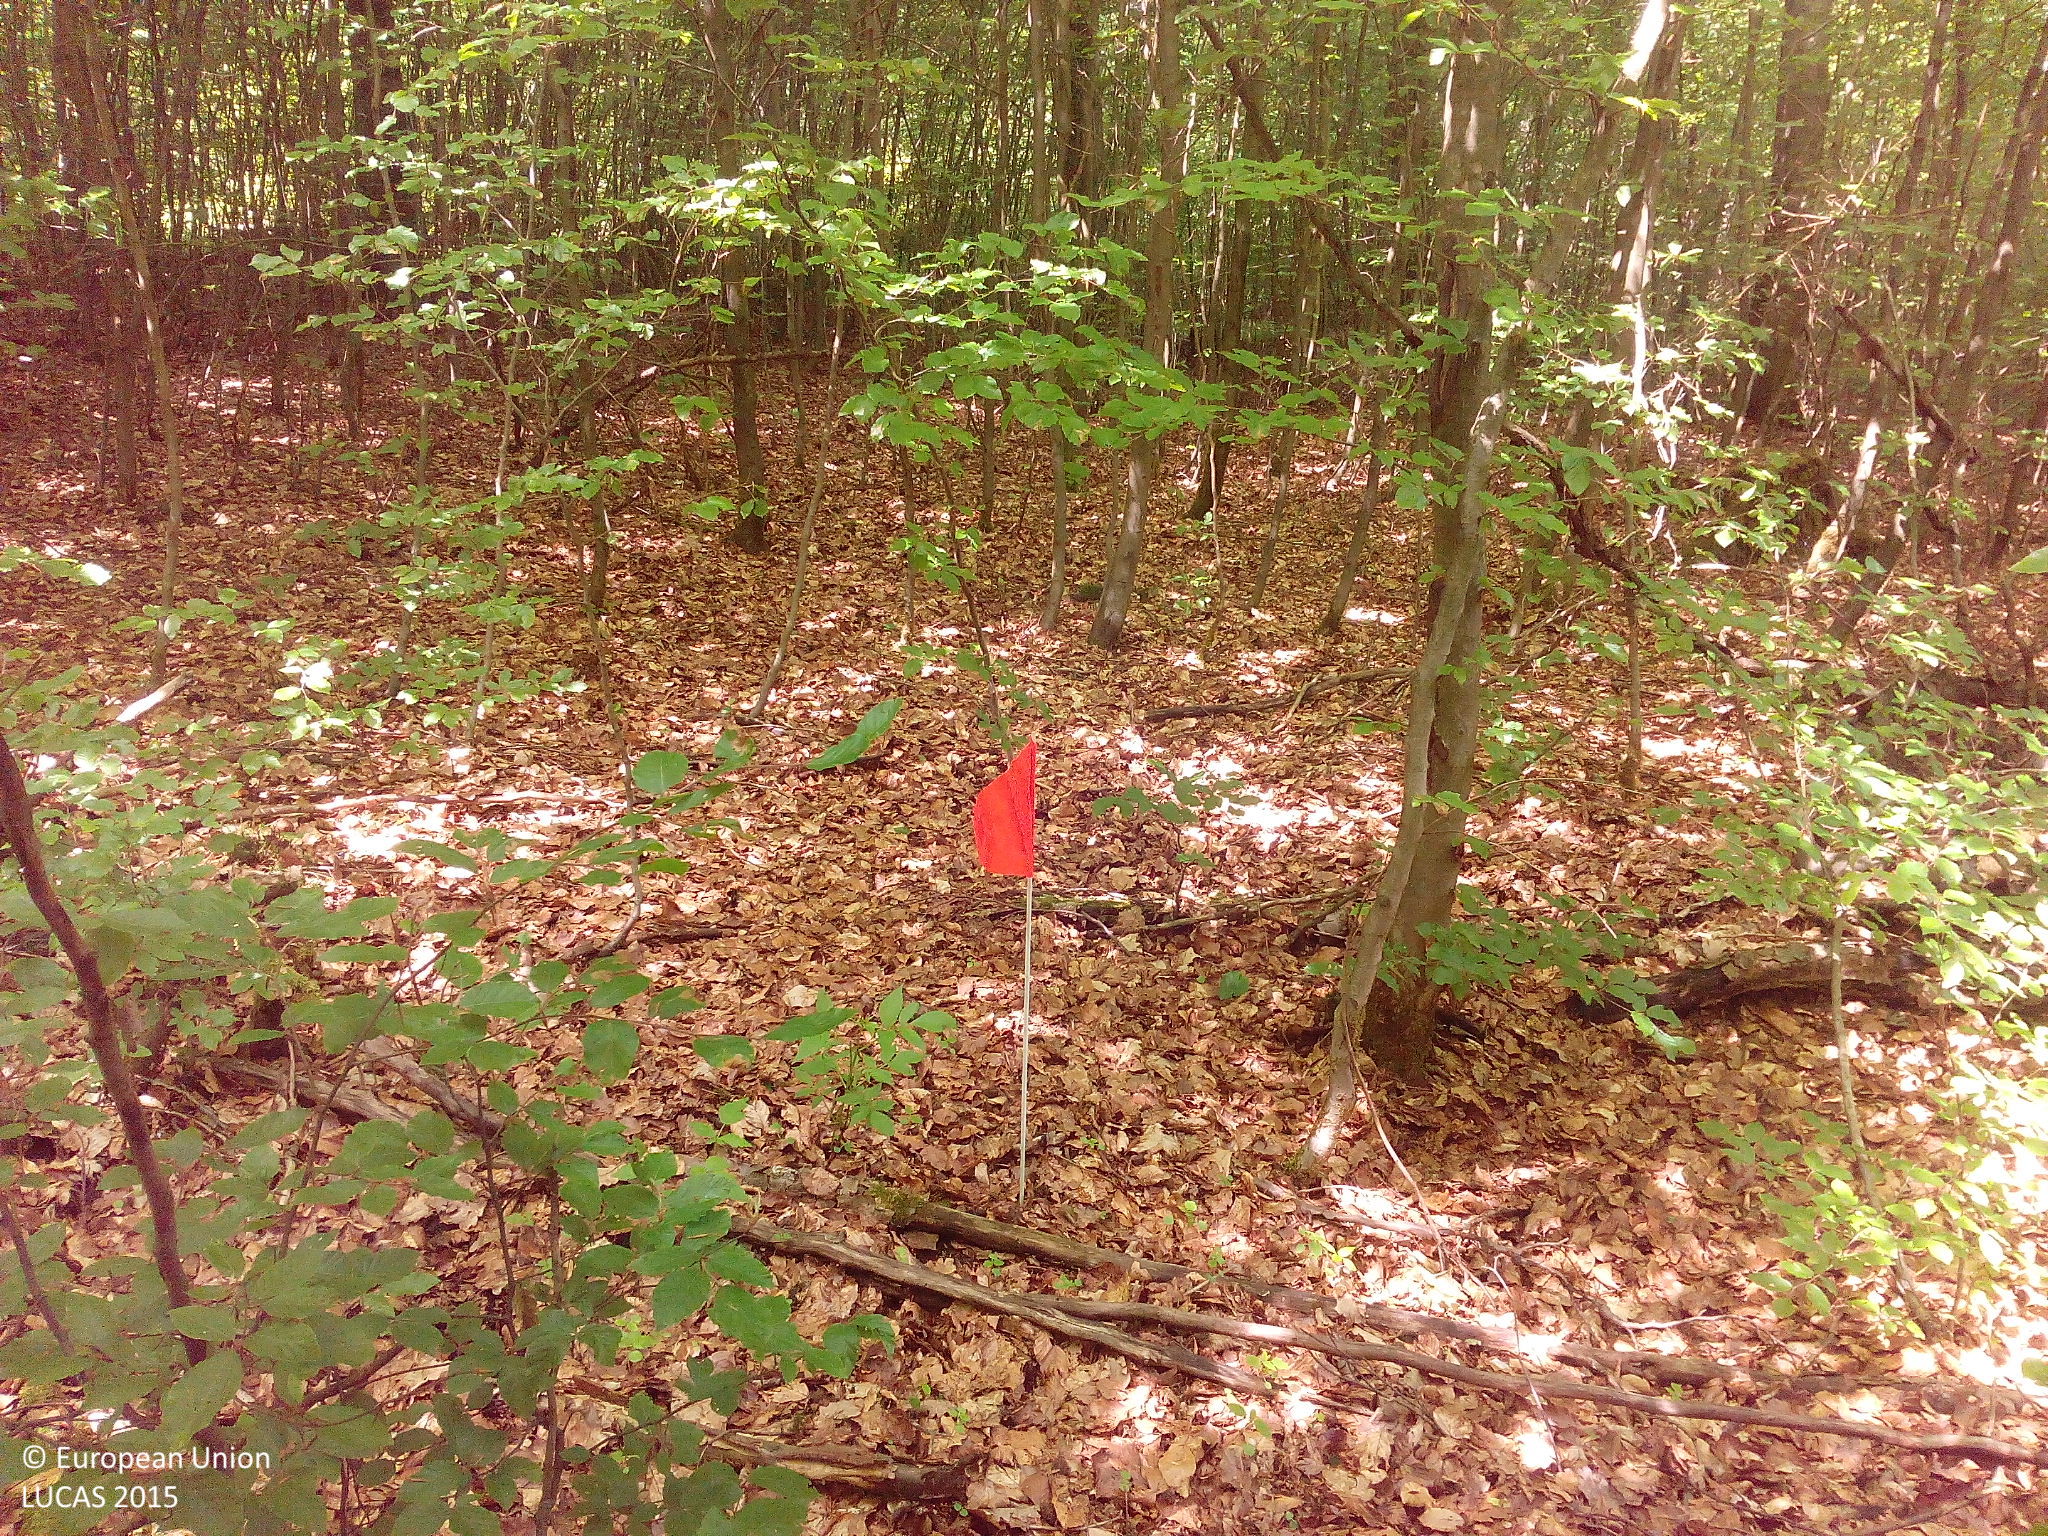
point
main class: Woodland
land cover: Broadleaved woodland
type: beech forest
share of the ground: > 75 %
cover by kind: broadleaved forest trees 95 %, unconsolidated bare surface 5 %
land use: Forestry
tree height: > 5 m
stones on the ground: < 10 %
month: May
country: DE
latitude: 51.2265
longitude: 9.6421
